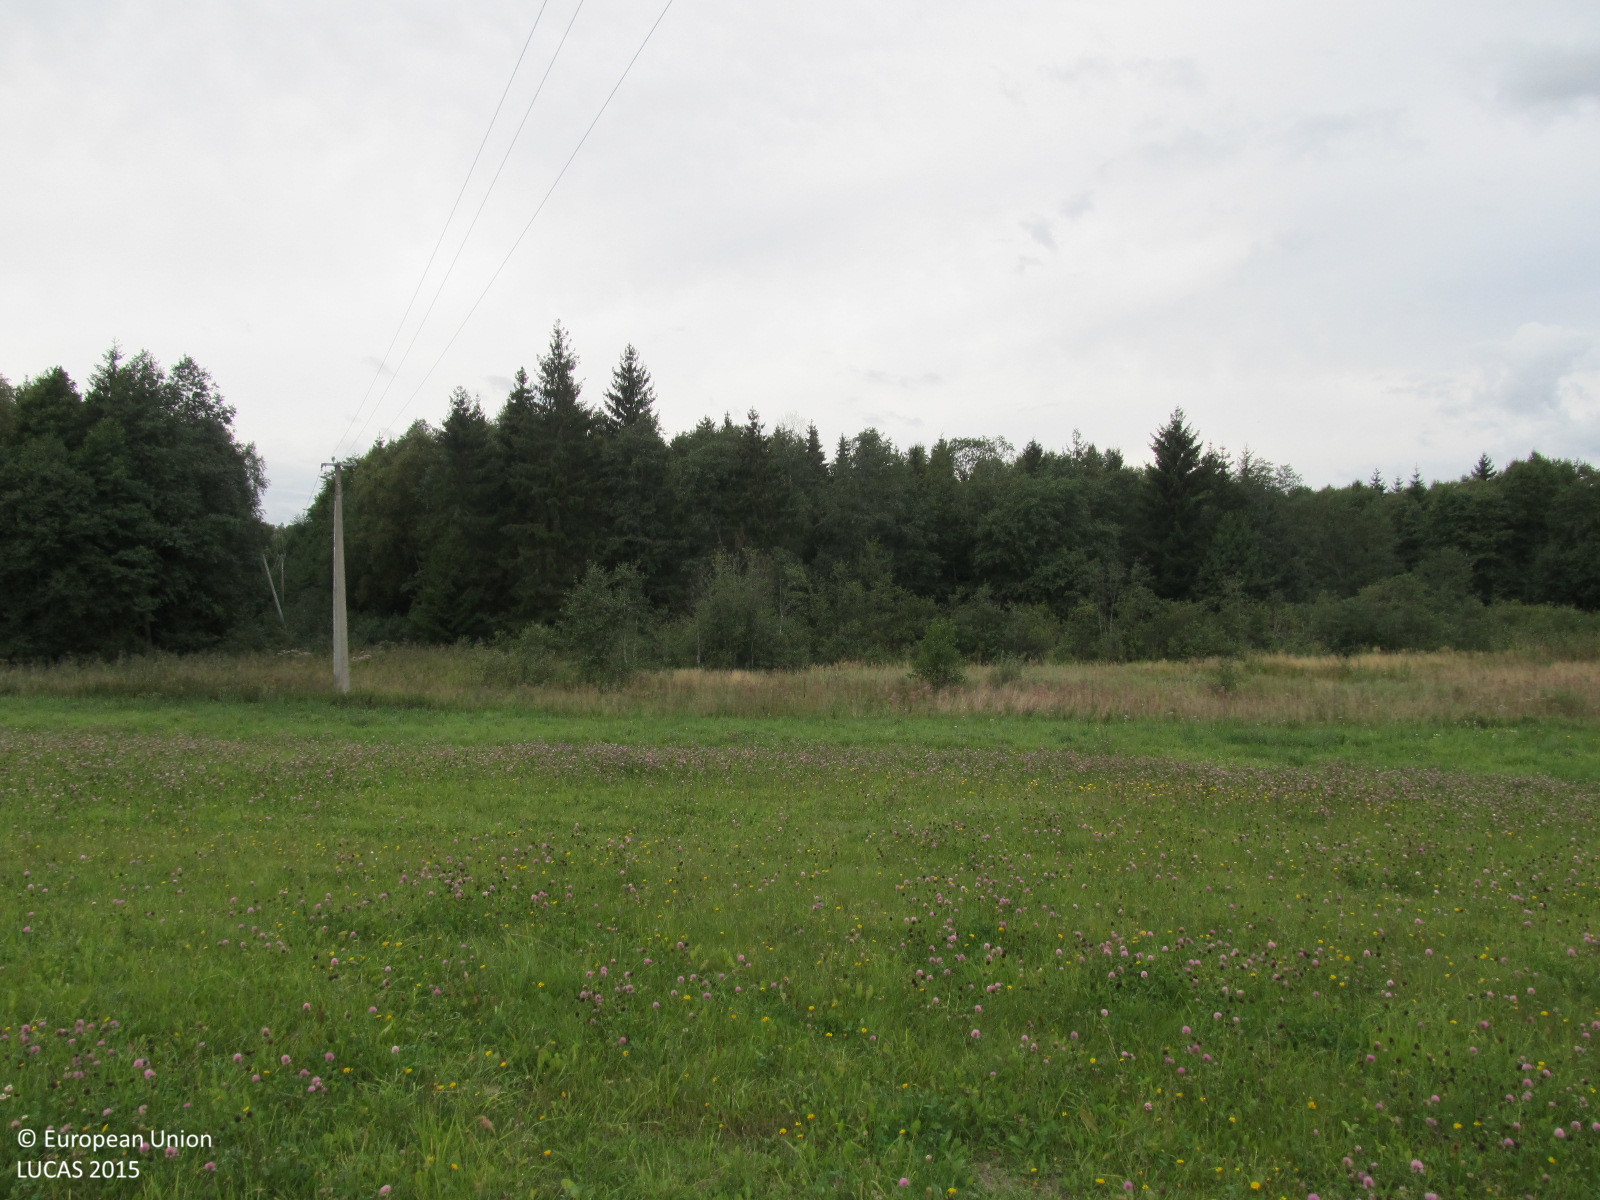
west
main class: Grassland
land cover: Grassland without tree/shrub cover
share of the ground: > 75 %
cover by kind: herbaceous plants 100 %
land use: Agriculture (excluding fallow land and kitchen gardens)
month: September
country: LT
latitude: 55.6545
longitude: 22.6018
